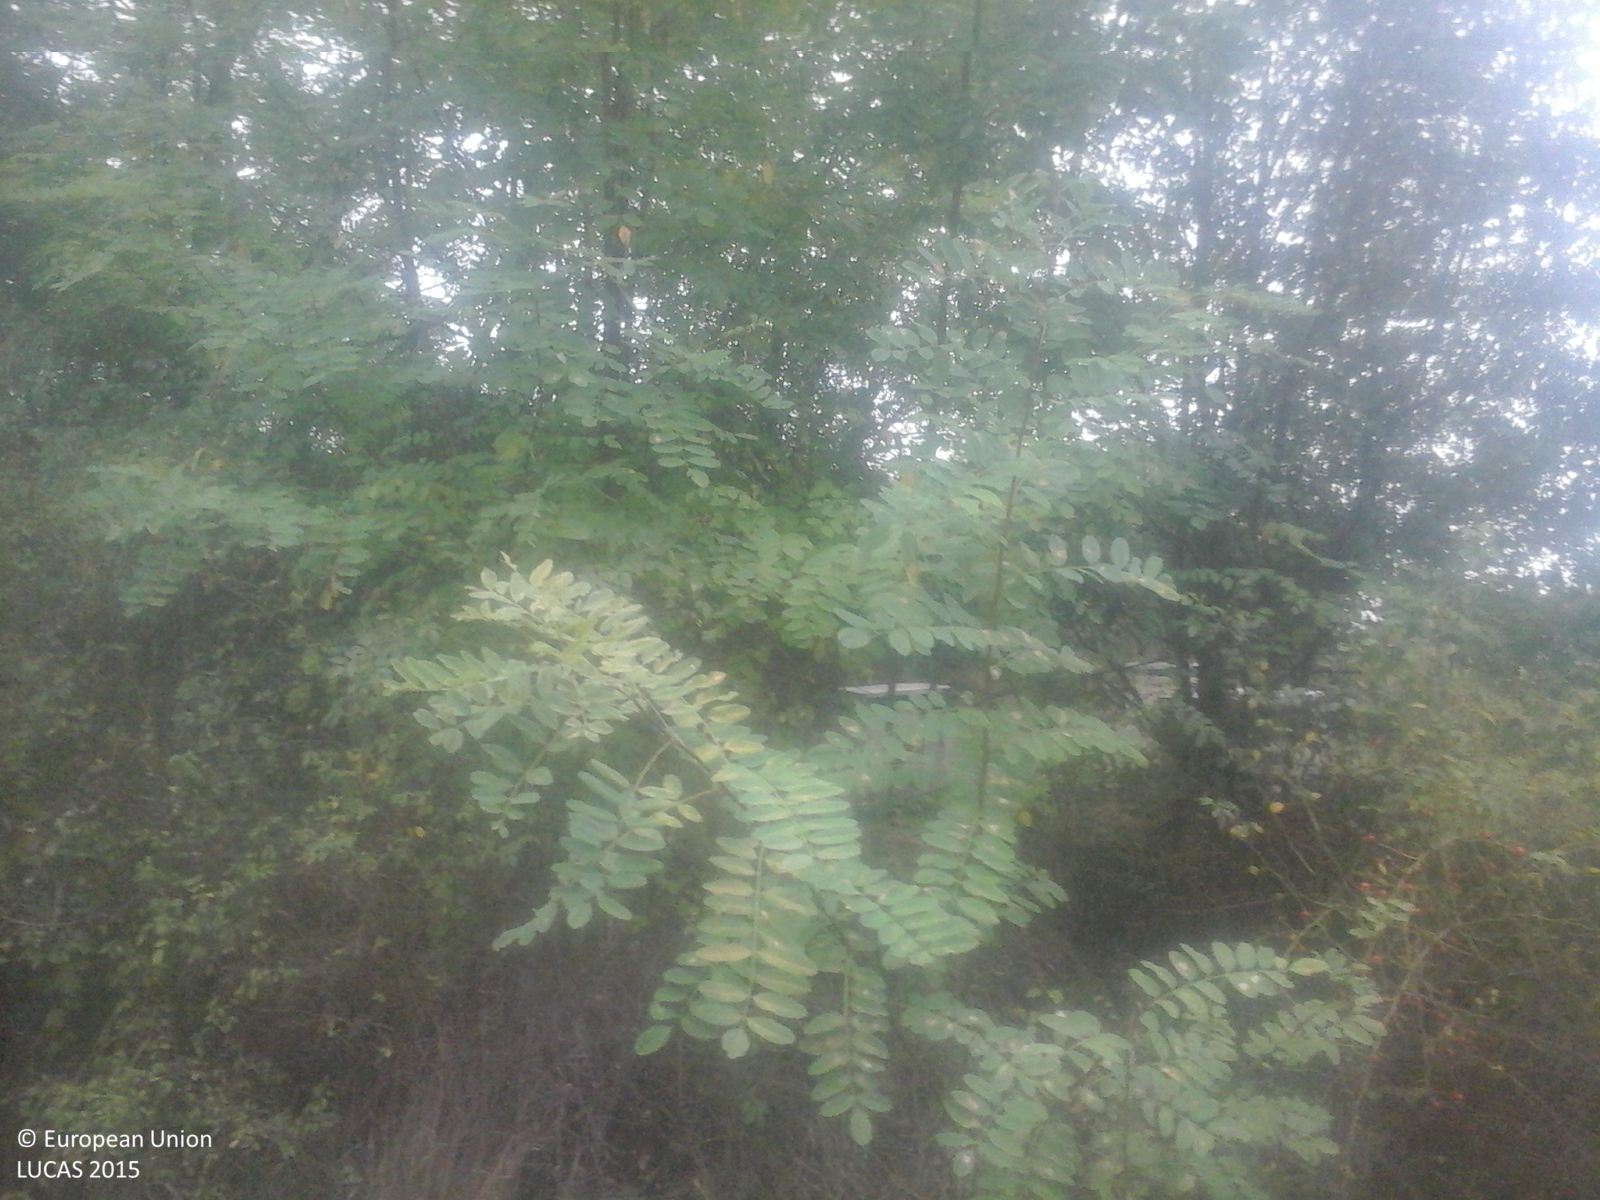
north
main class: Woodland
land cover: Broadleaved woodland
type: exotic forest
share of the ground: > 75 %
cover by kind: broadleaved forest trees 100 %
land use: Forestry
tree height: > 5 m
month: September
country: RO
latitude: 45.5468
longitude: 21.9887
